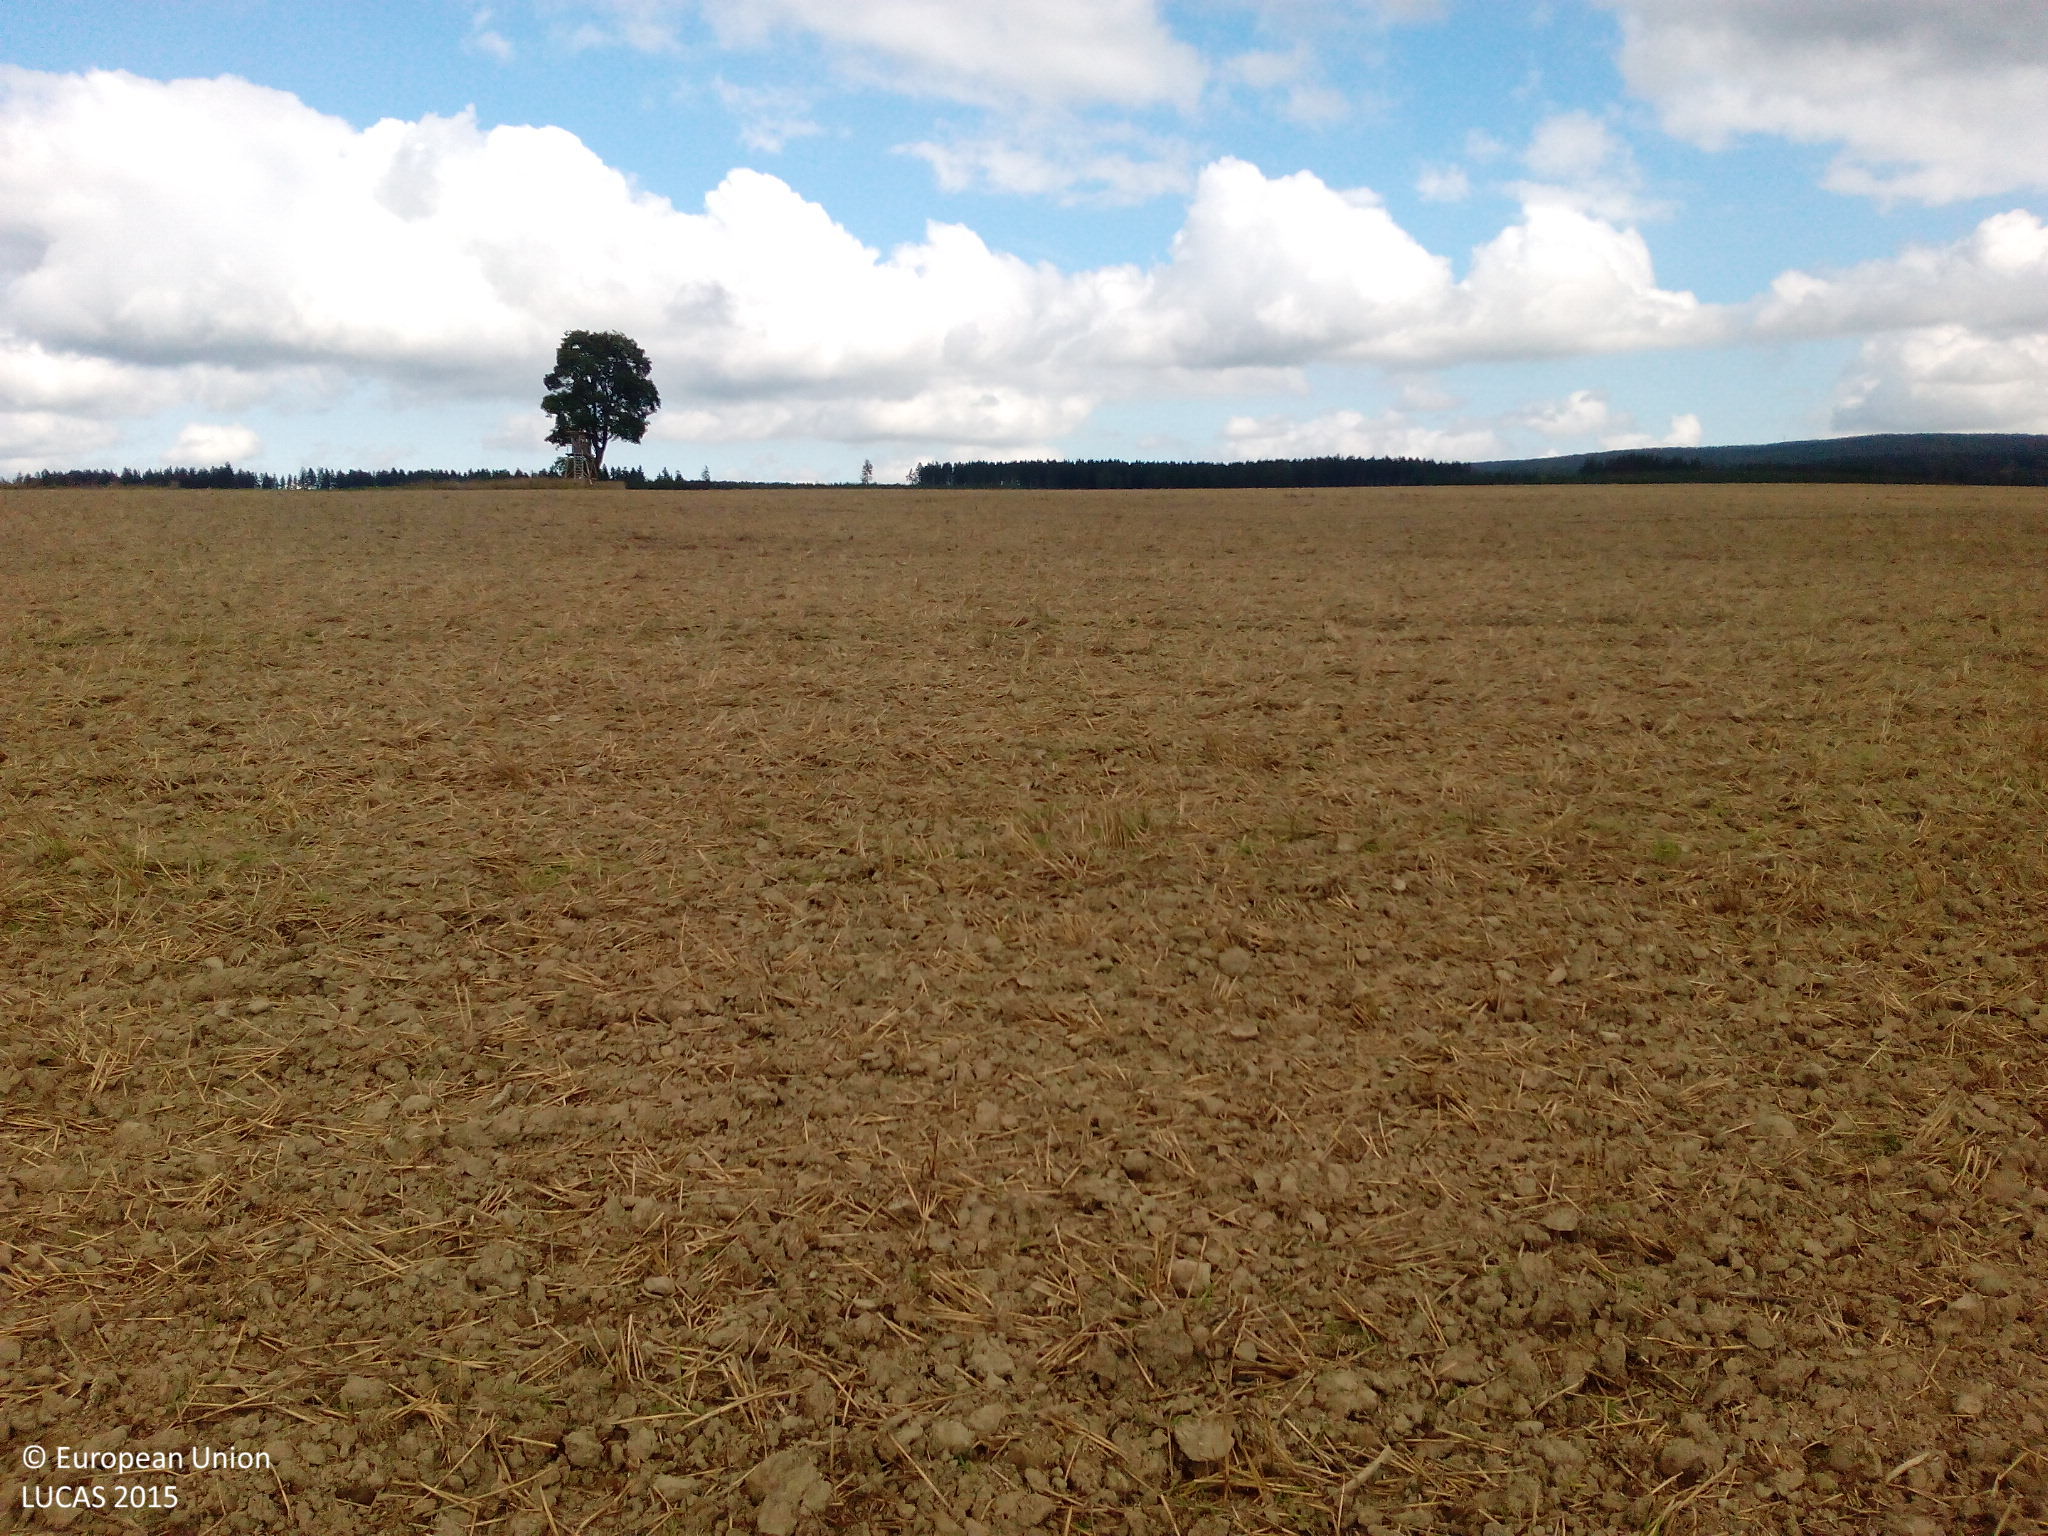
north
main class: Cropland
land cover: Common wheat
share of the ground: < 10 %
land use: Agriculture (excluding fallow land and kitchen gardens)
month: September
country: DE
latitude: 51.6540
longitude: 11.0260
